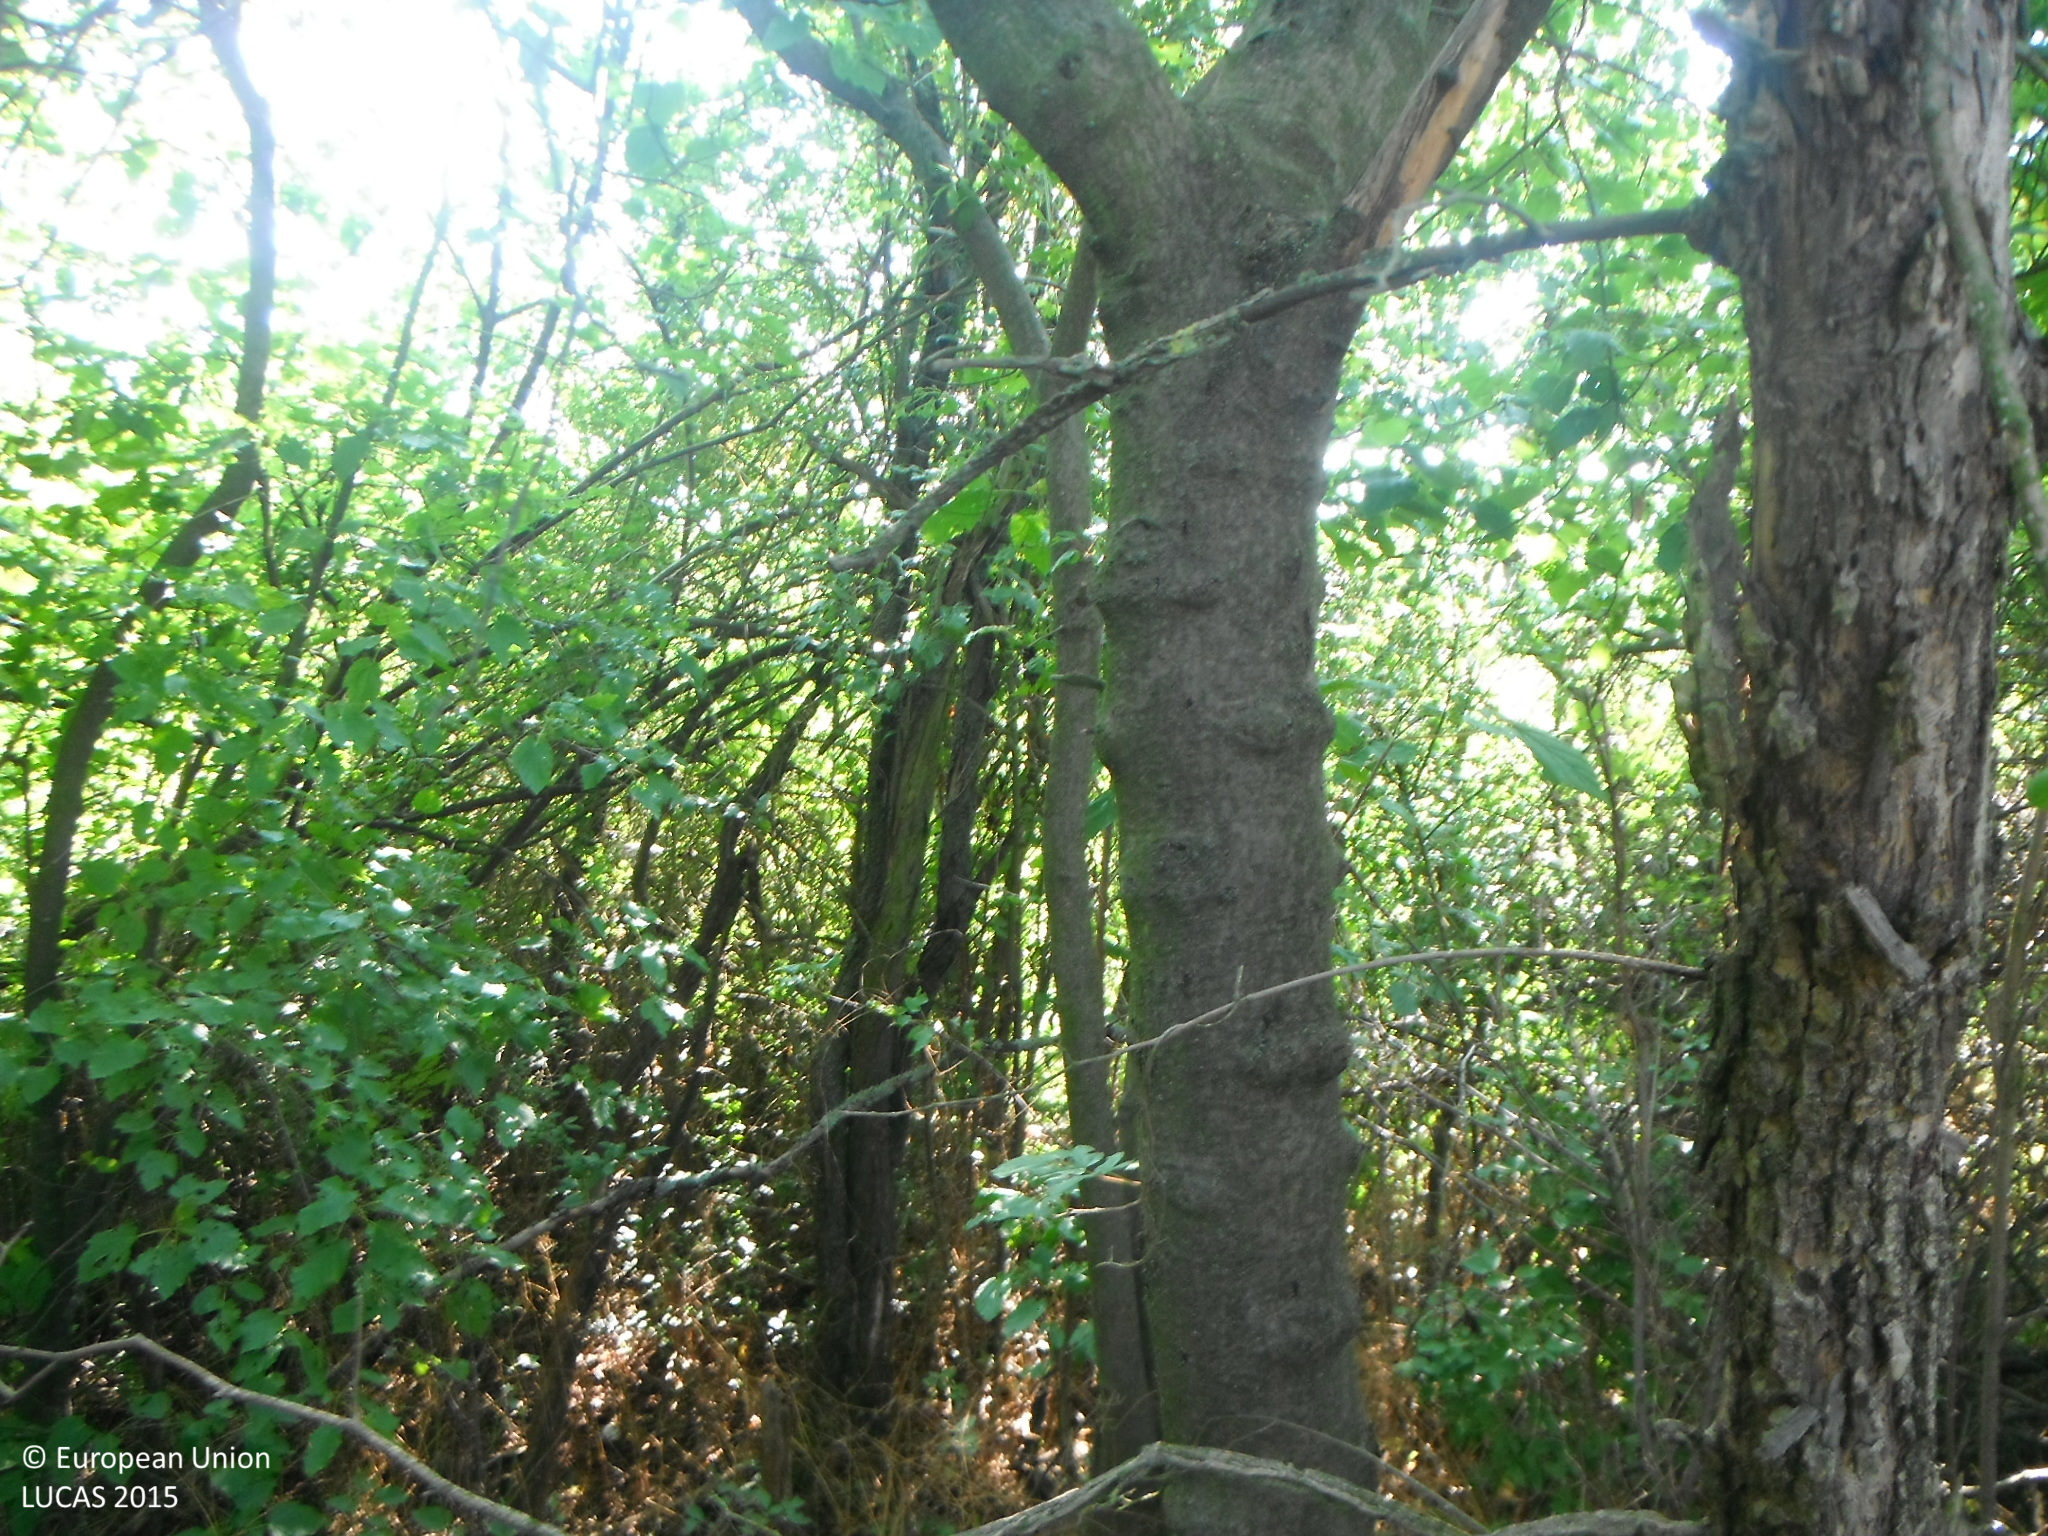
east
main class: Shrubland
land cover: Shrubland with sparse tree cover
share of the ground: > 75 %
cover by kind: shrubs 95 %, broadleaved forest trees 5 %
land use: Semi-natural and natural areas not in use
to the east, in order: Shrubland with sparse tree cover; Tracks; Grassland with sparse tree/shrub cover; Shrubland without tree cover; Broadleaved woodland; Grassland without tree/shrub cover; Tracks; Grassland without tree/shrub cover; Shrubland with sparse tree cover; Shrubland without tree cover; Shrubland with sparse tree cover
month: June
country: SK
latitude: 48.2058
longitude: 18.9136
